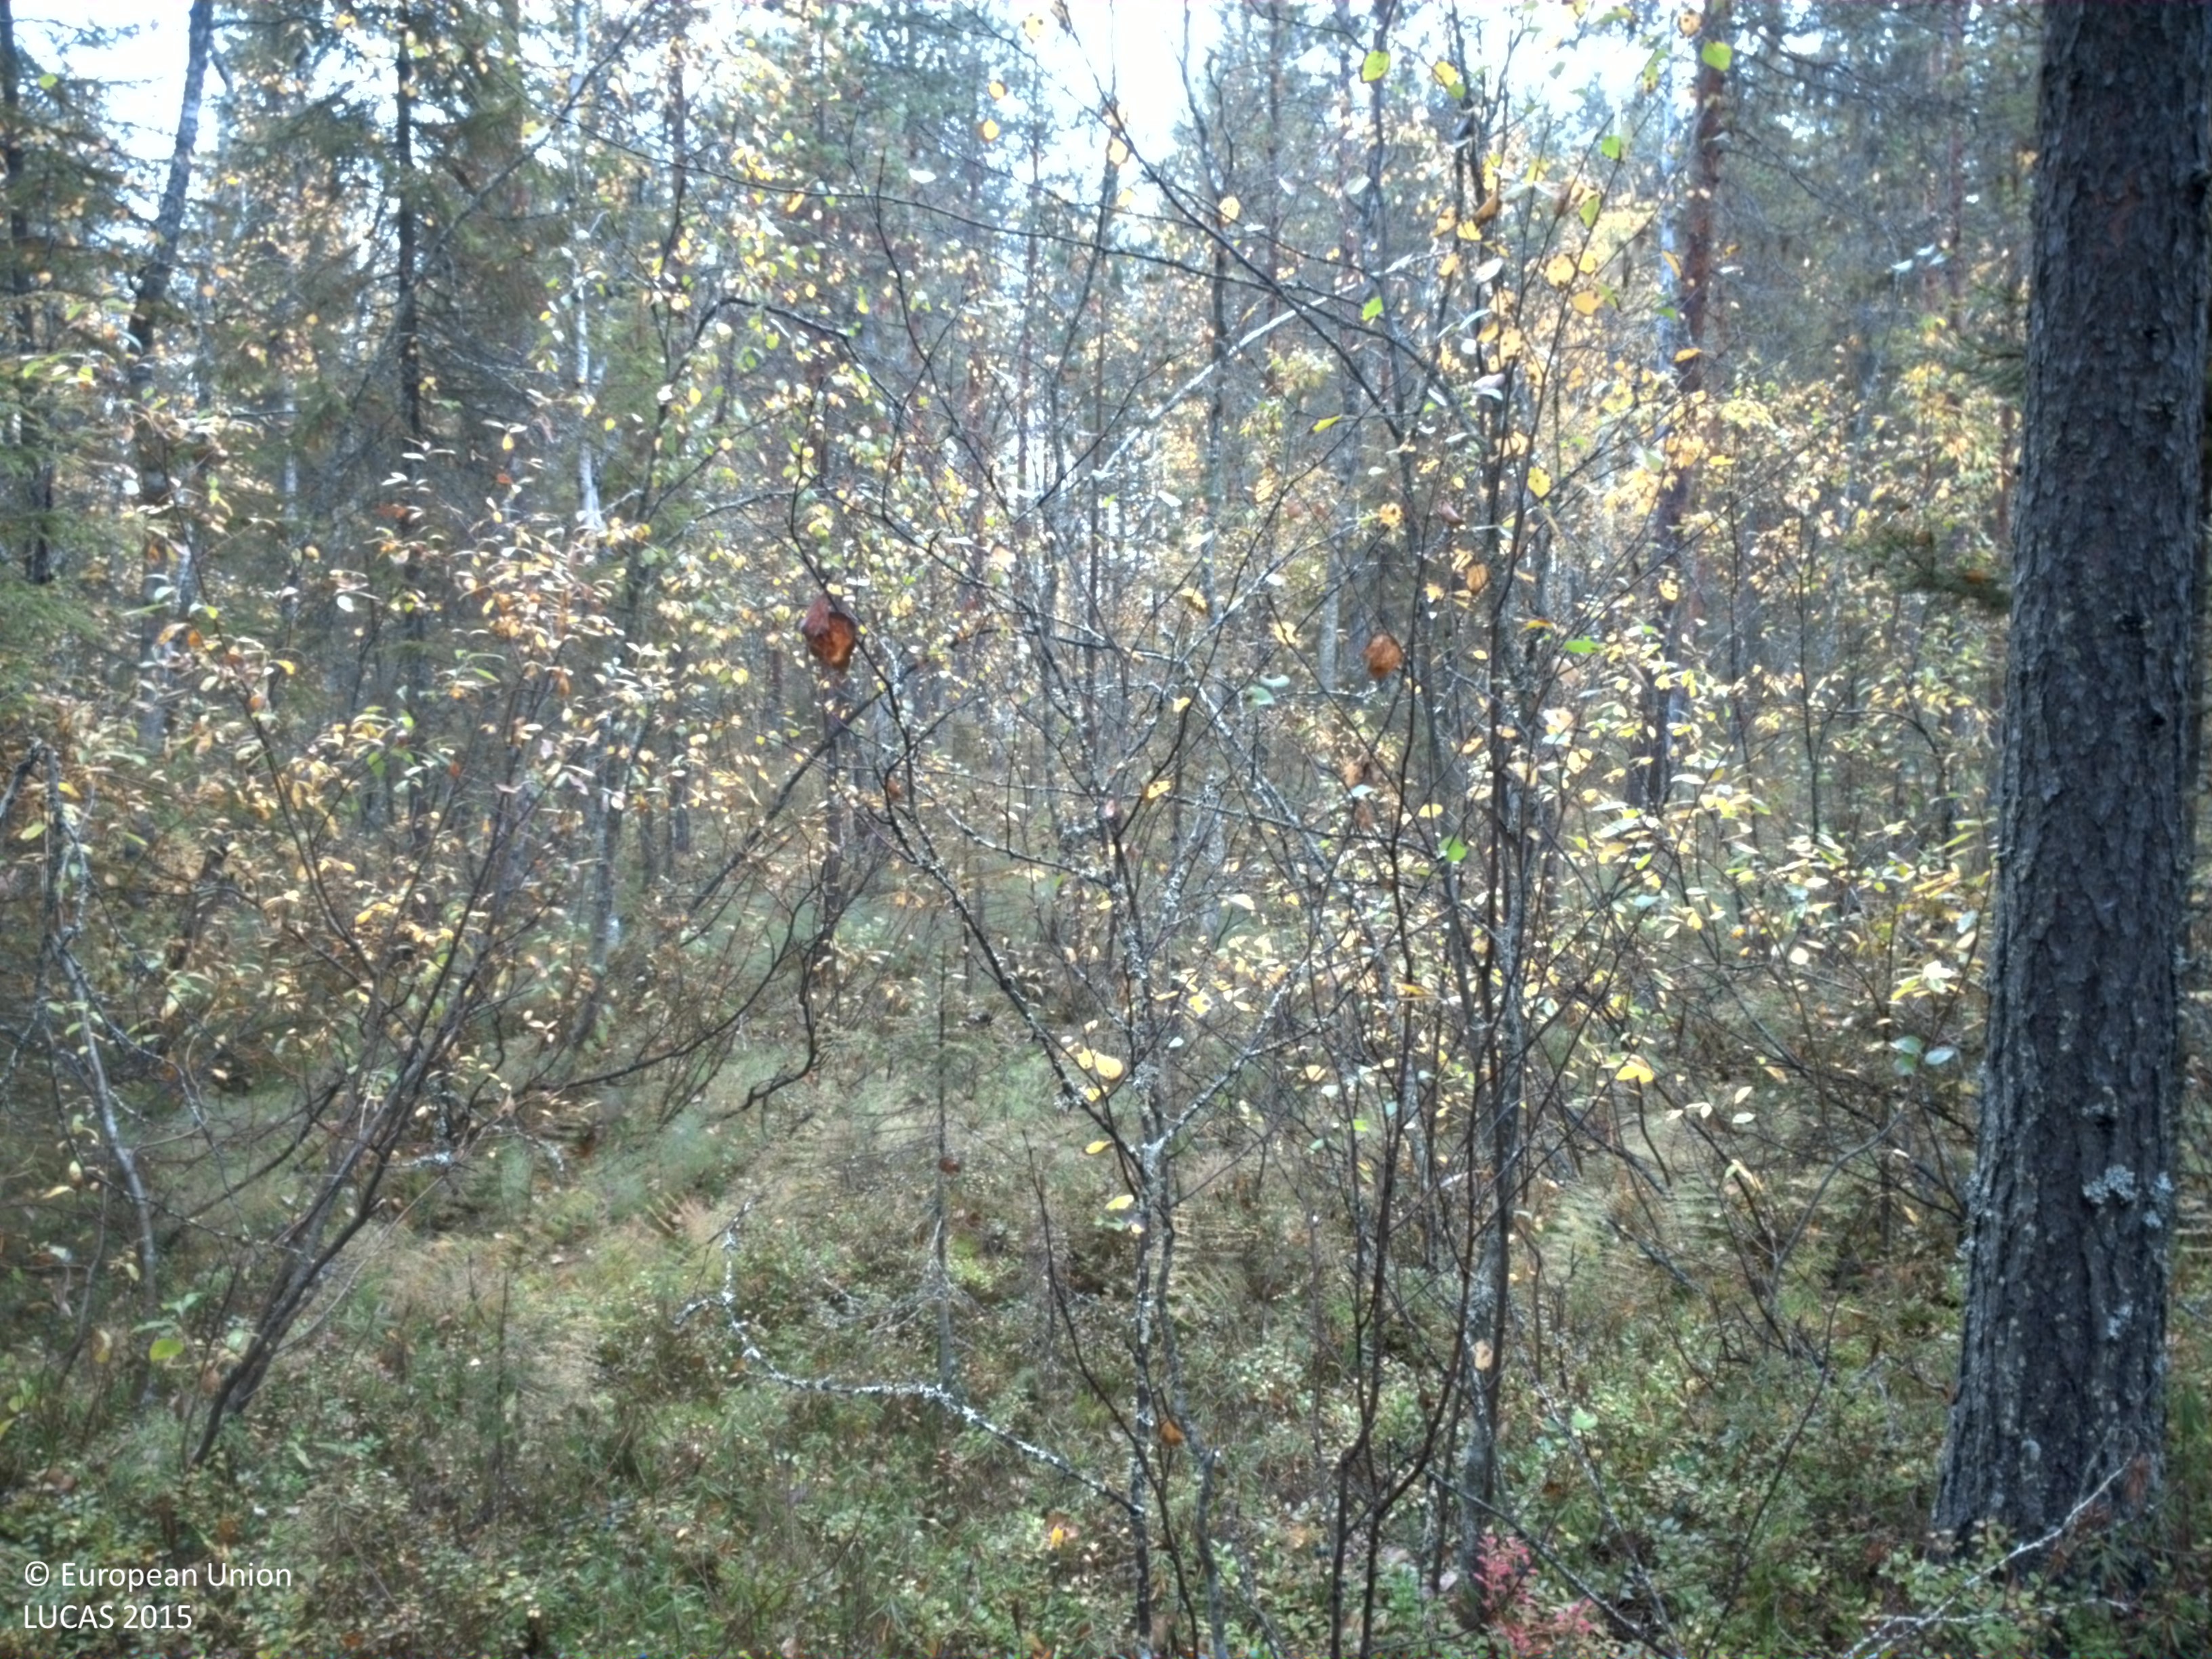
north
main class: Woodland
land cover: Other mixed woodland
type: boreal forest
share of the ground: 25 - 50 %
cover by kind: shrubs 45 %, coniferous forest trees 30 %, broadleaved forest trees 20 %, lichens and mosses 5 %
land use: Forestry
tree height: > 5 m
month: September
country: SE
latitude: 65.9003
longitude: 22.0237
